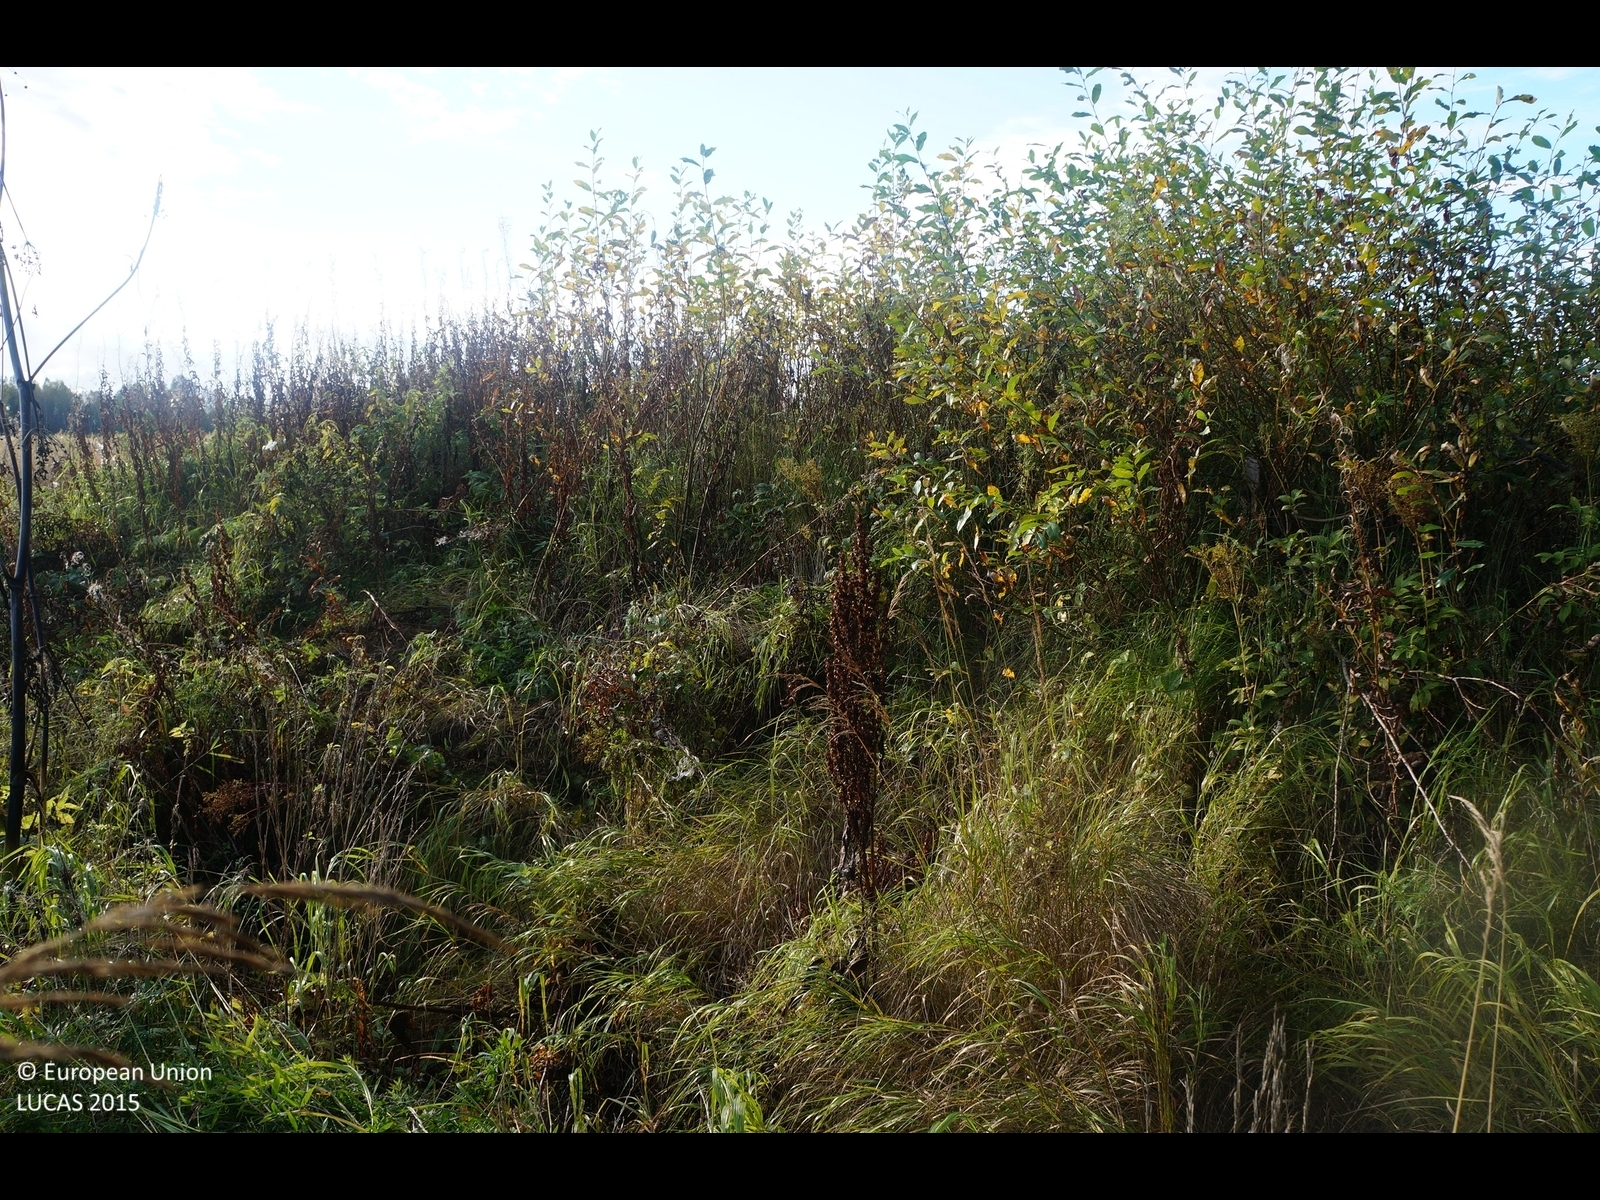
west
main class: Woodland
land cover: Spruce dominated mixed woodland
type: boreal forest
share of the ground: 50 - 75 %
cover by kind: coniferous forest trees 50 %, broadleaved forest trees 20 %, shrubs 20 %, lichens and mosses 10 %
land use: Forestry
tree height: > 5 m
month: September
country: FI
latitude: 64.2721
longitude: 24.5881
